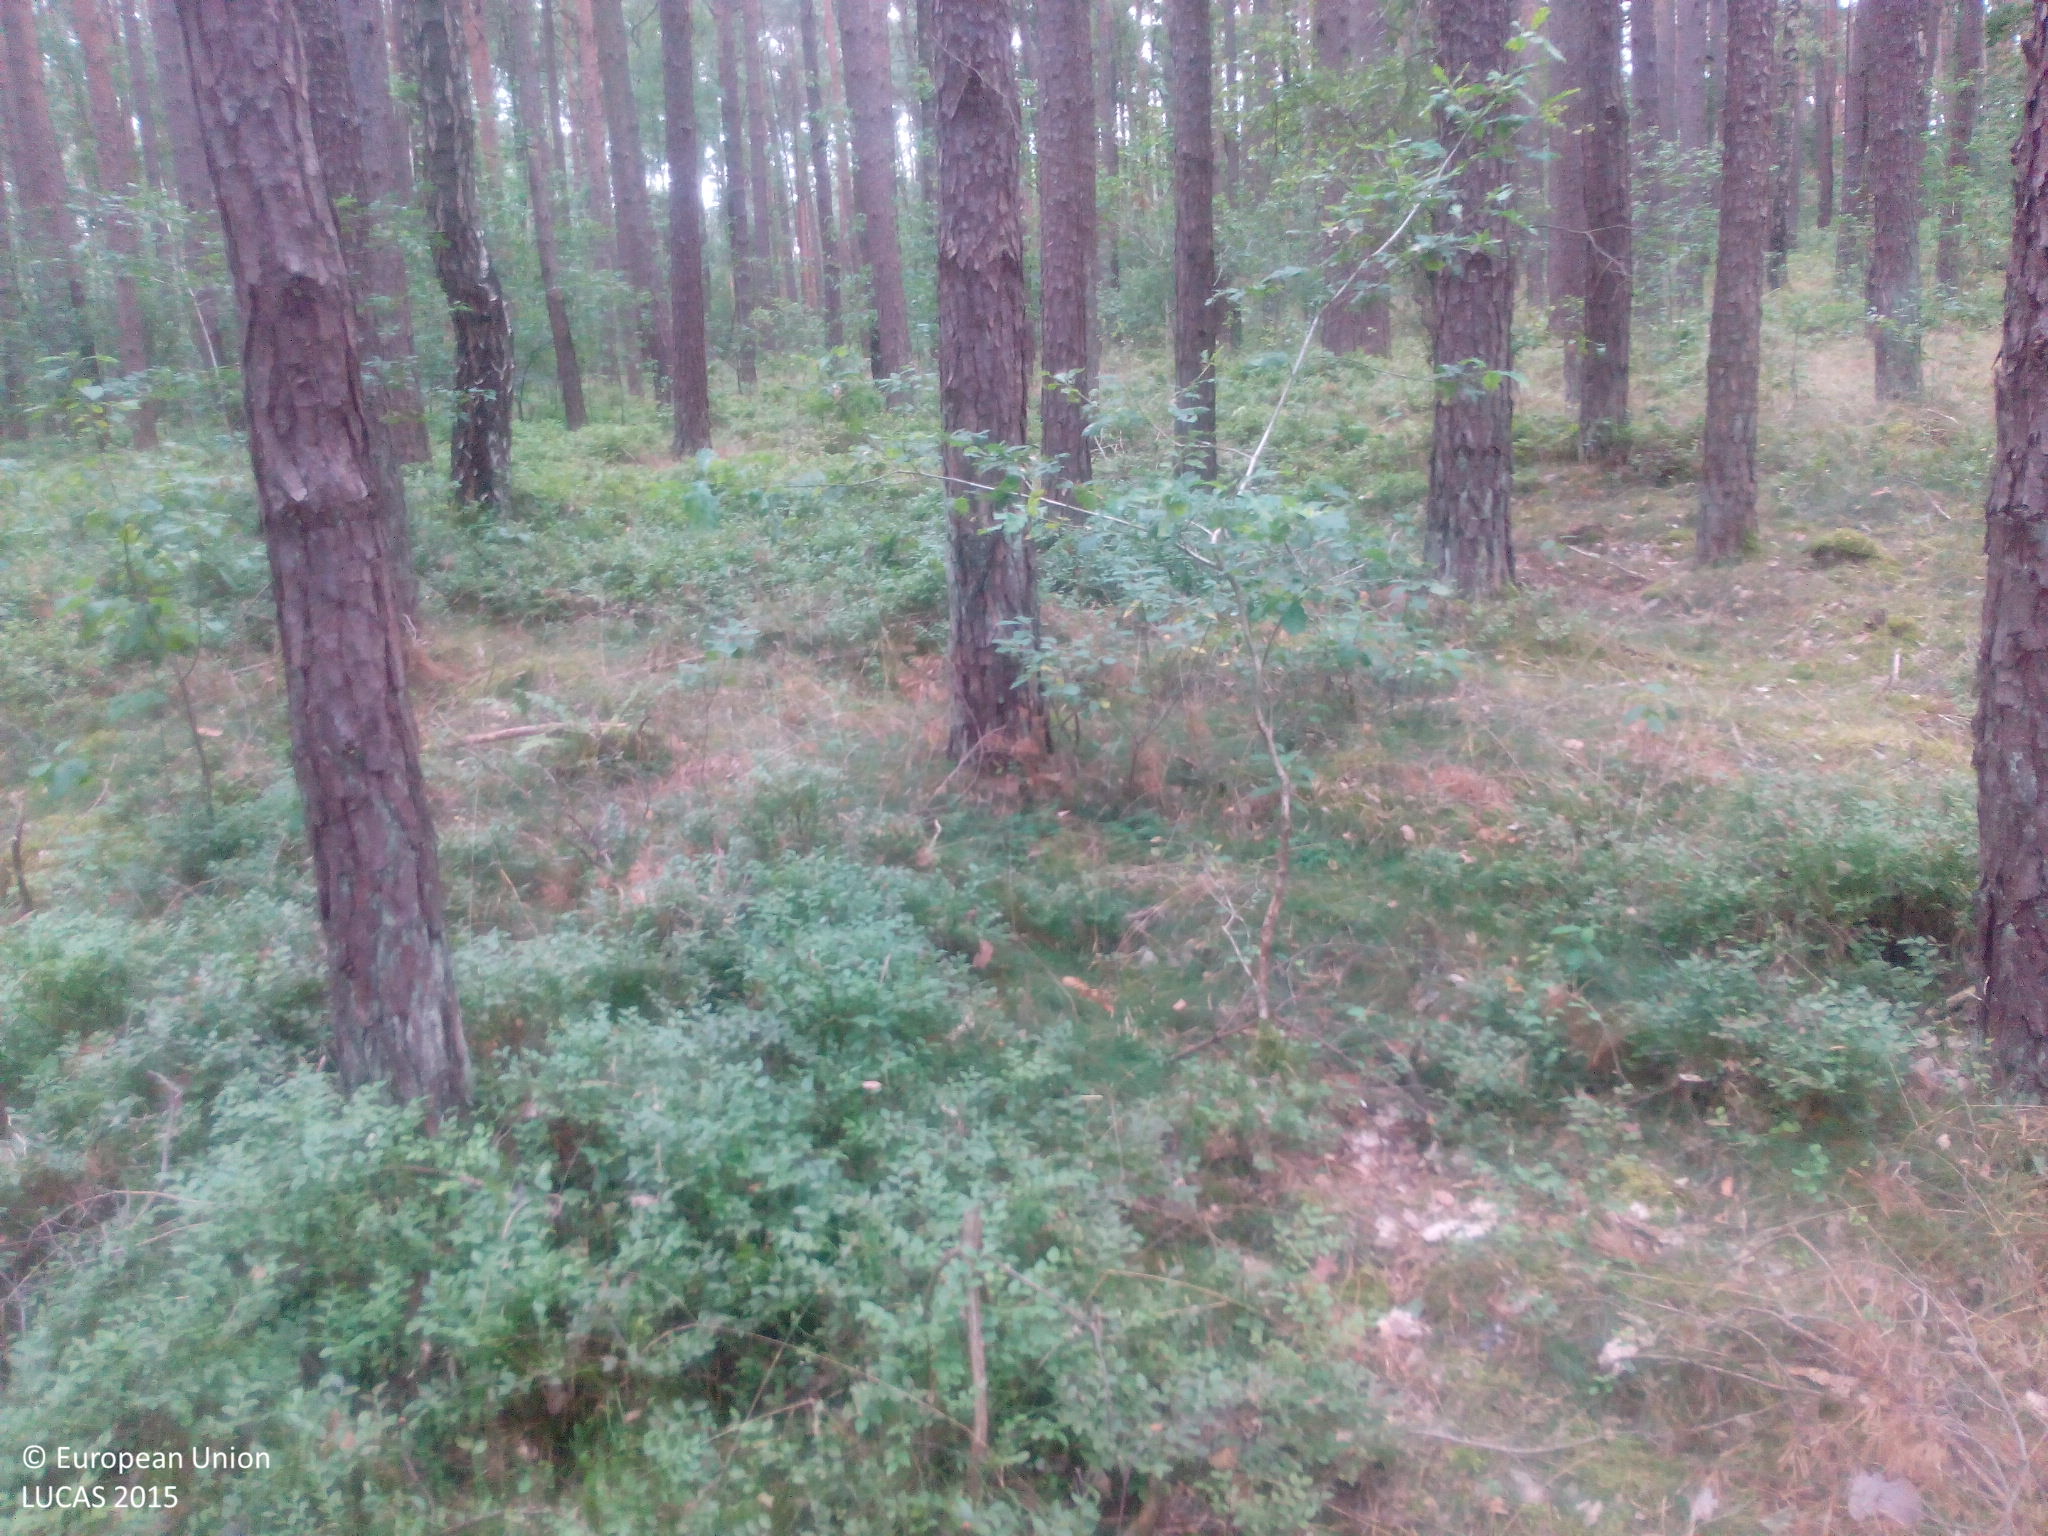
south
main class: Woodland
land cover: Pine dominated coniferous woodland
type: hemiboreal forest and nemoral coniferous forest and mixed broadleaved-coniferous forest
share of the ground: > 75 %
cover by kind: coniferous forest trees 70 %, shrubs 20 %, broadleaved forest trees 10 %
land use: Forestry
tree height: > 5 m
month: July
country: DE
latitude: 49.6052
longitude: 10.8991
